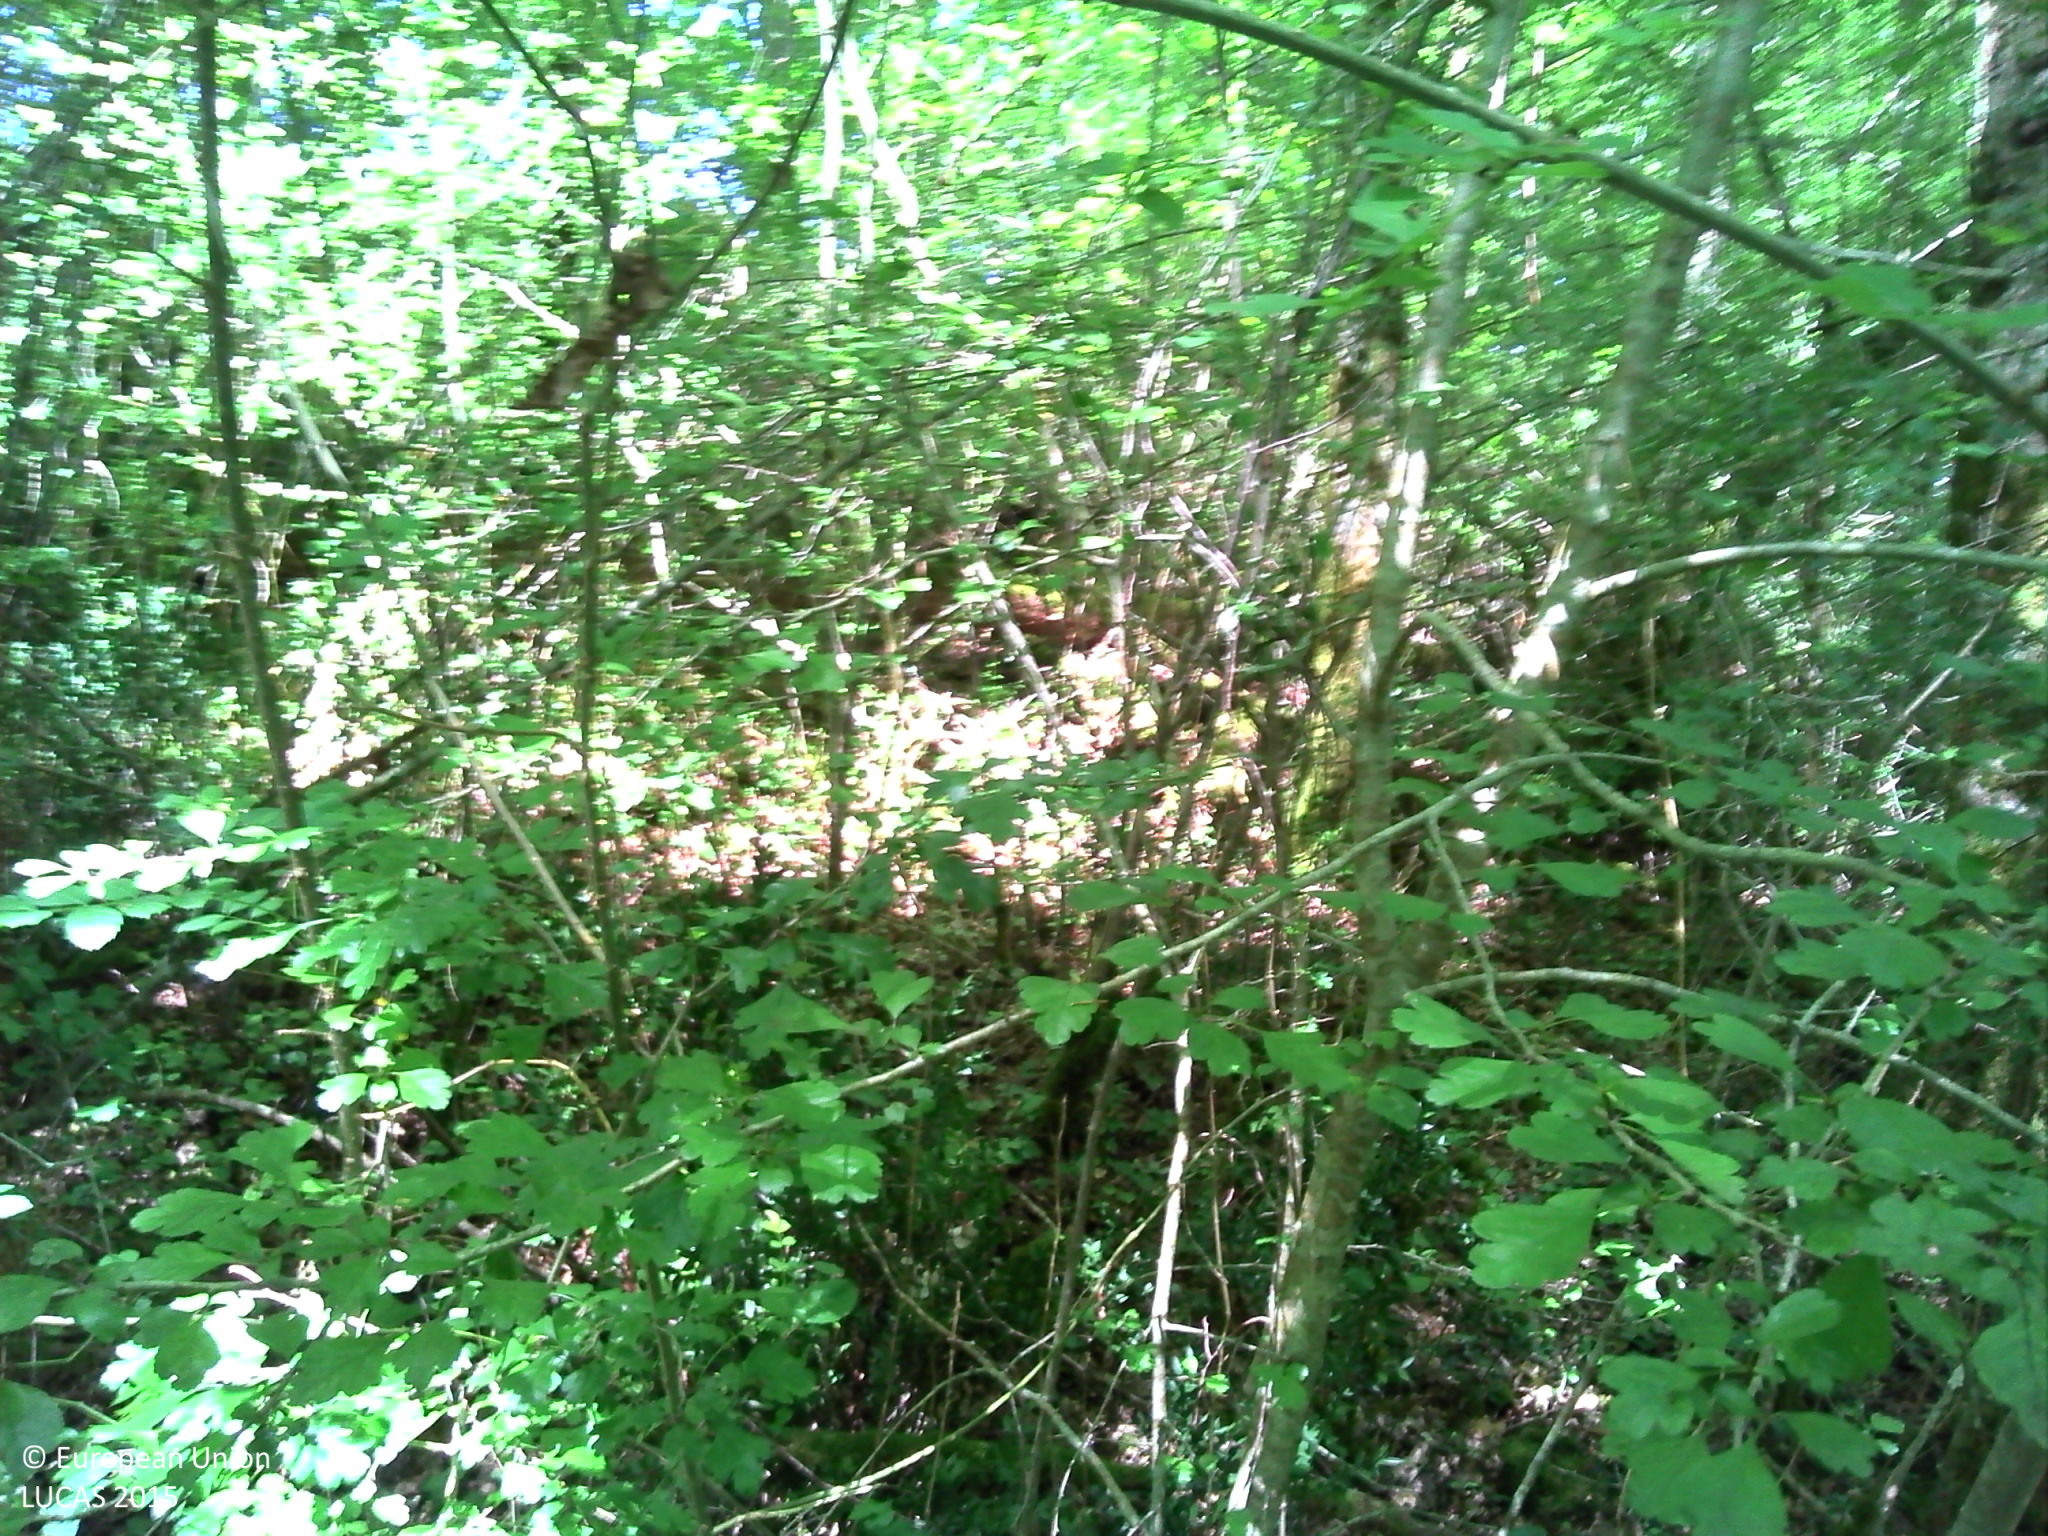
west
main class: Woodland
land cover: Broadleaved woodland
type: mesophytic deciduous forest
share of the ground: > 75 %
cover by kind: broadleaved forest trees 95 %, herbaceous plants 5 %
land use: Semi-natural and natural areas not in use
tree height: > 5 m
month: June
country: FR
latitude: 44.7862
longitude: 1.7956
